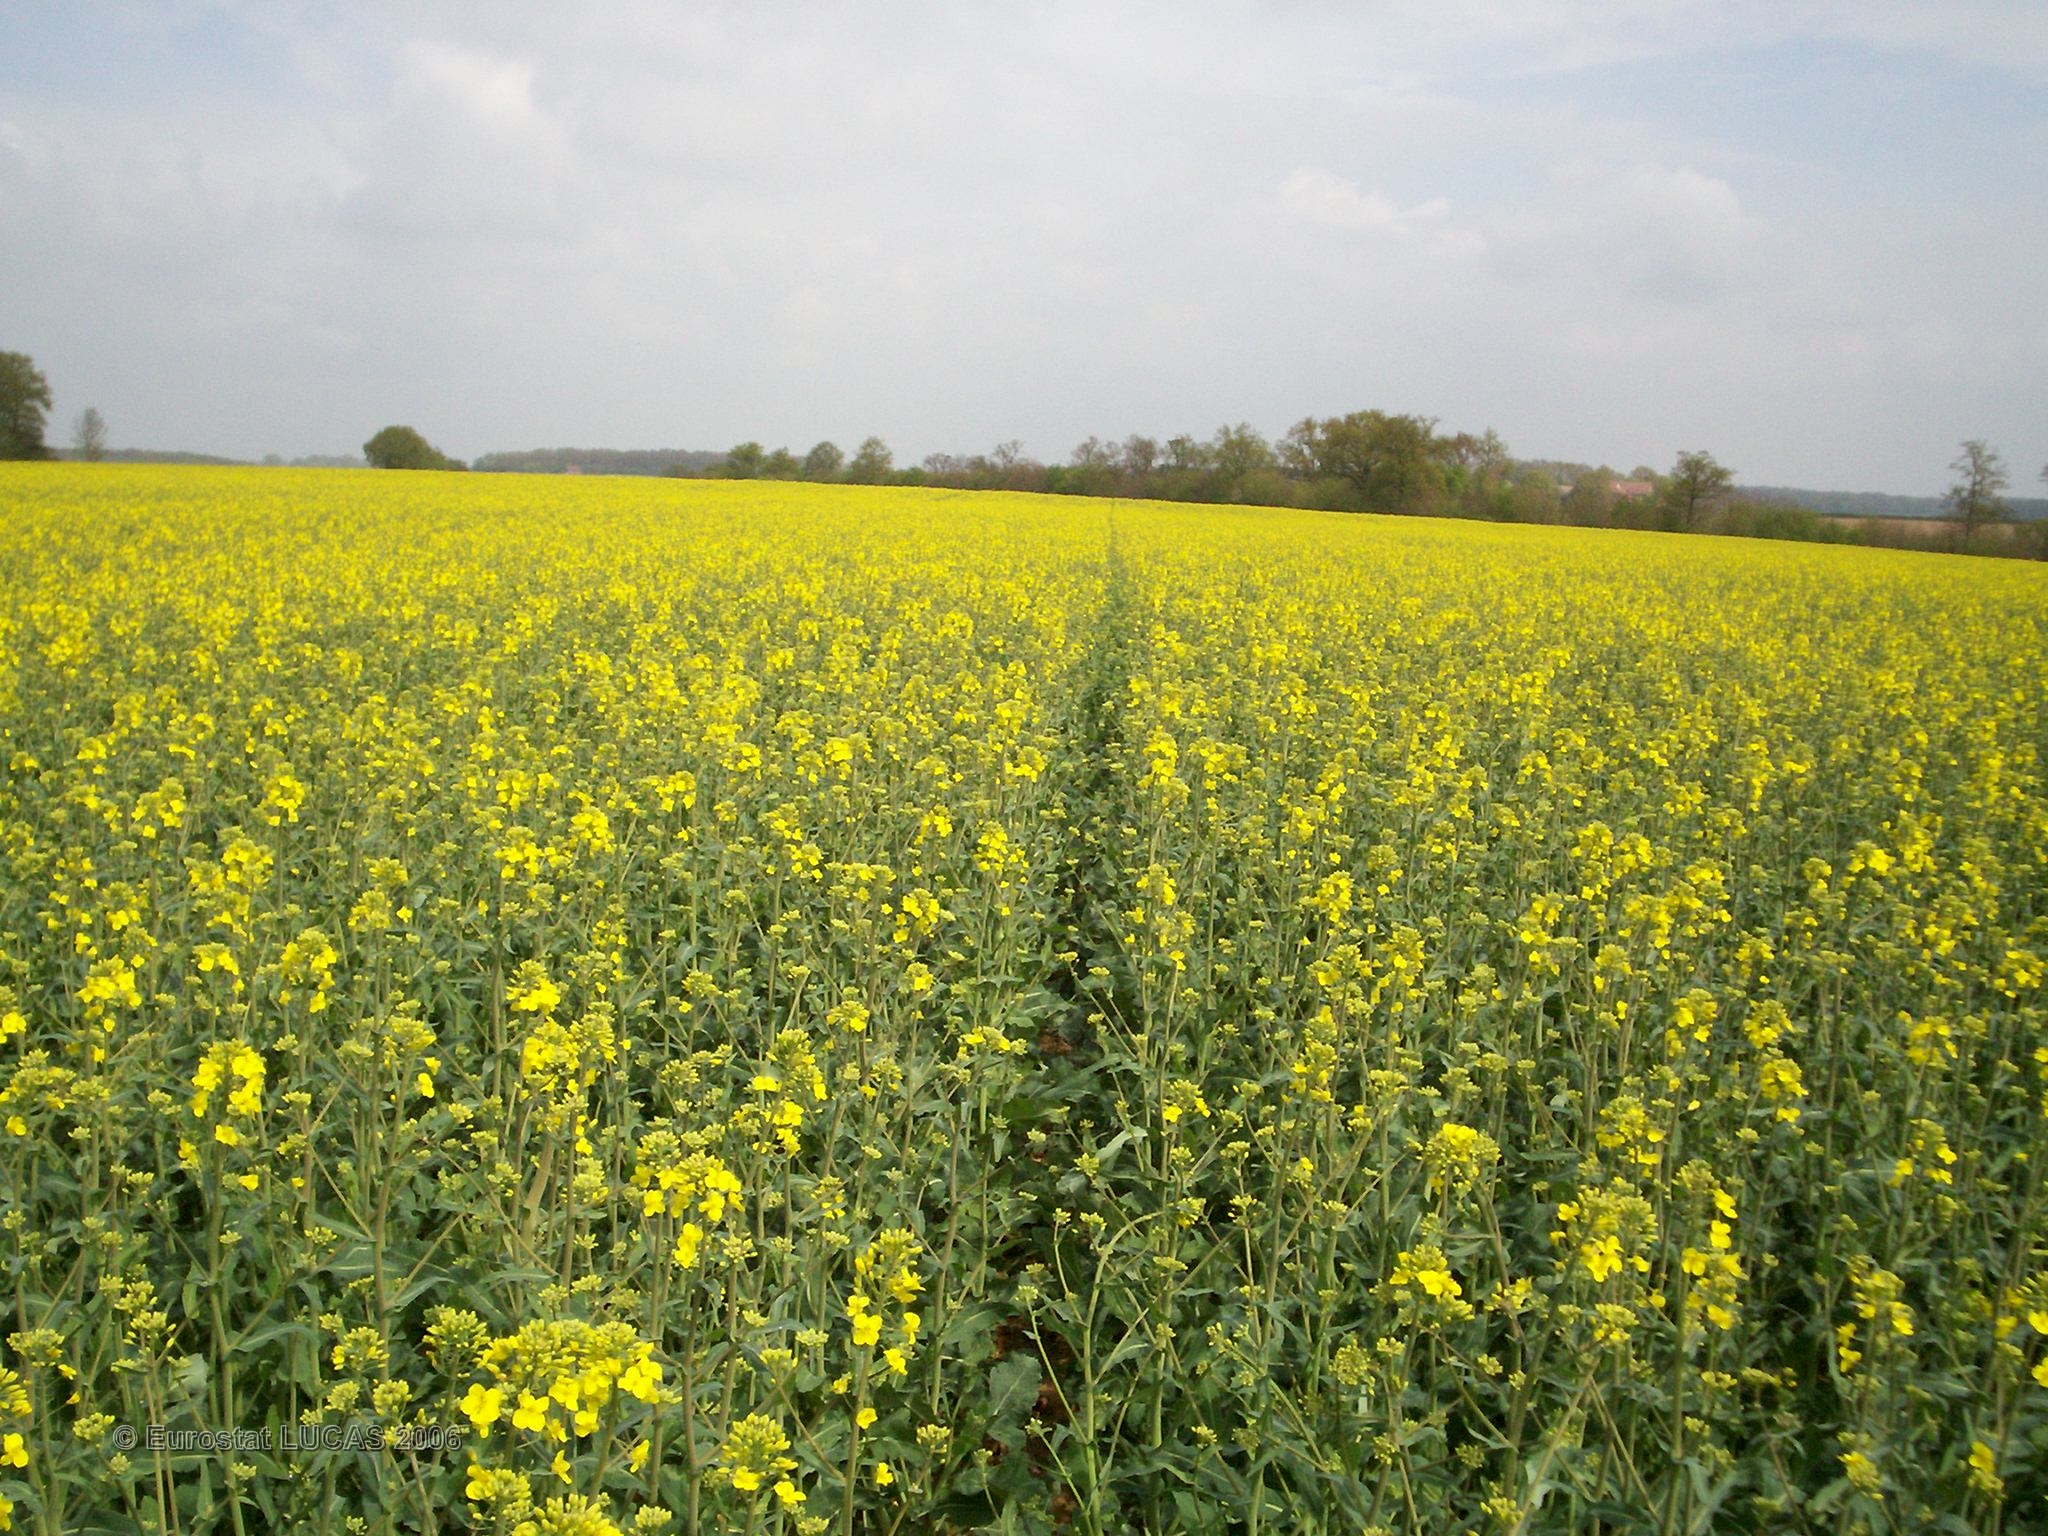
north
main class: Cropland
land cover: Rape and turnip rape
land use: Agriculture (excluding fallow land and kitchen gardens)
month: April
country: FR
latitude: 47.8370
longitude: 2.9789
